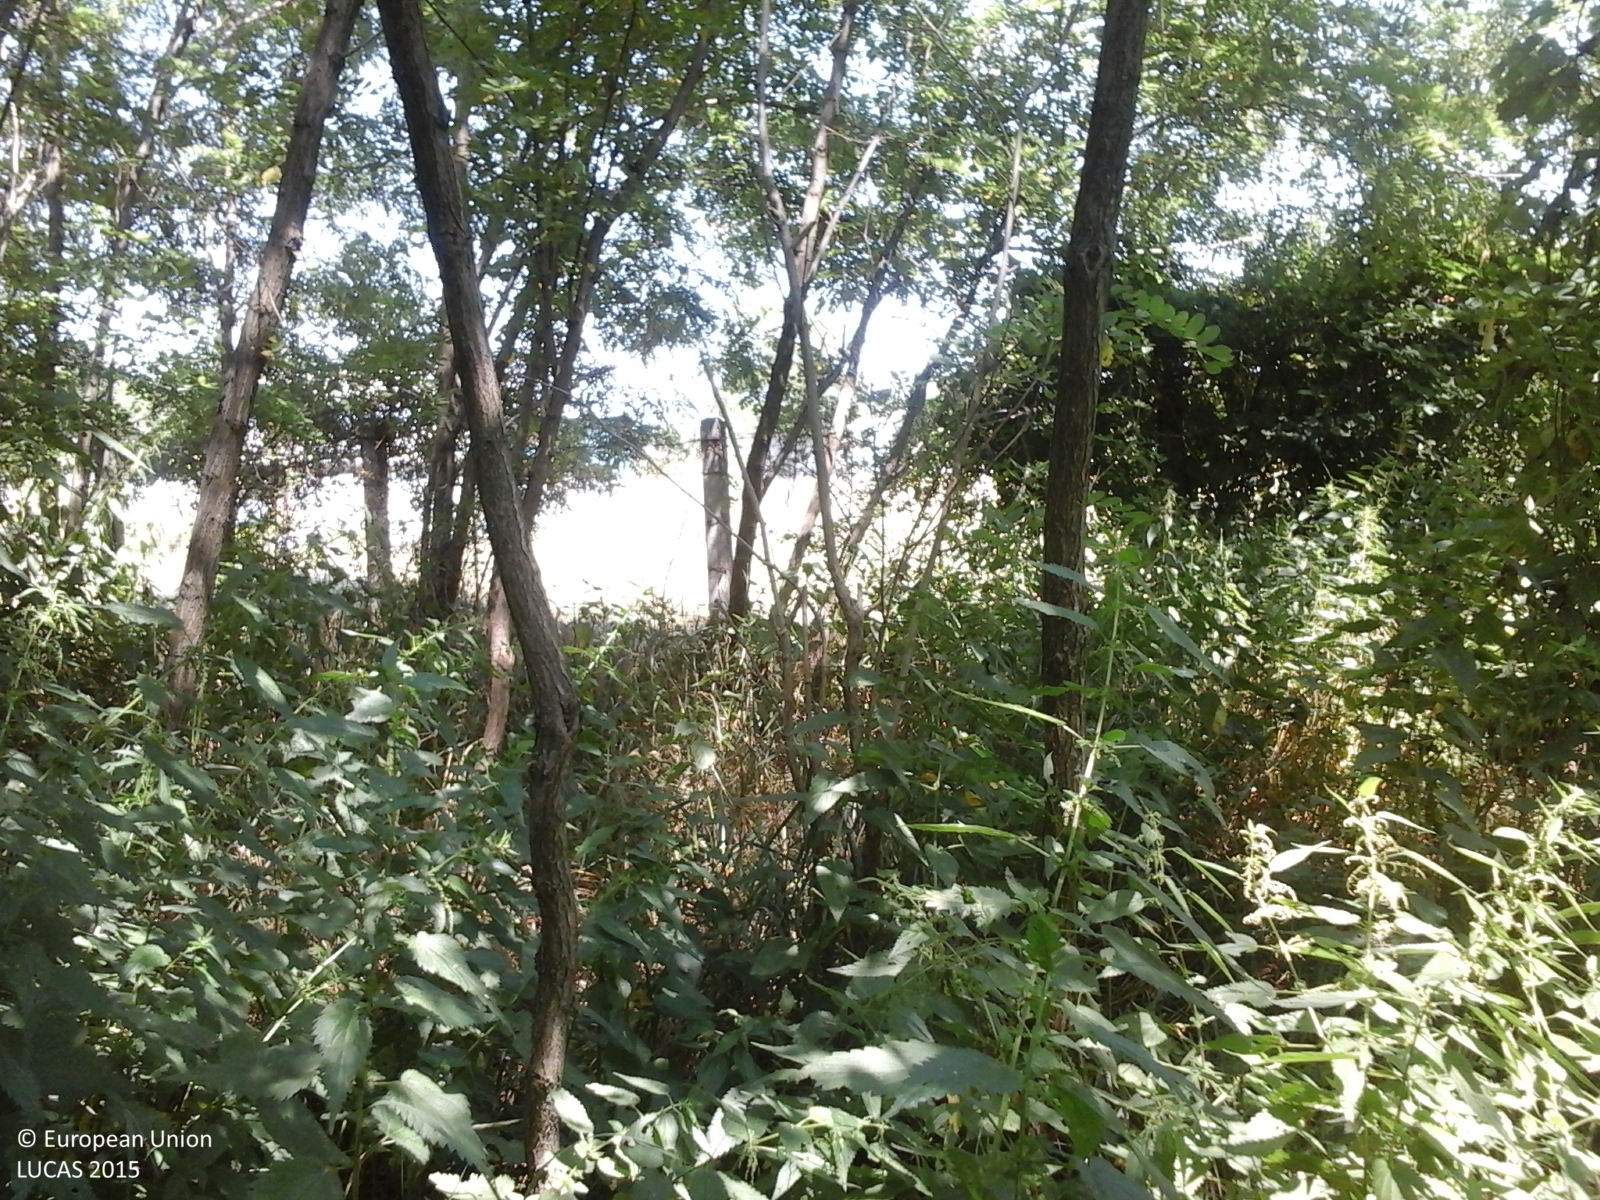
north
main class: Woodland
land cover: Broadleaved woodland
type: thermophilous deciduous forest
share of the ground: > 75 %
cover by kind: broadleaved forest trees 100 %
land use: Forestry
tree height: > 5 m
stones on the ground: < 10 %
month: July
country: RO
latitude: 44.7833
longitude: 24.5453
